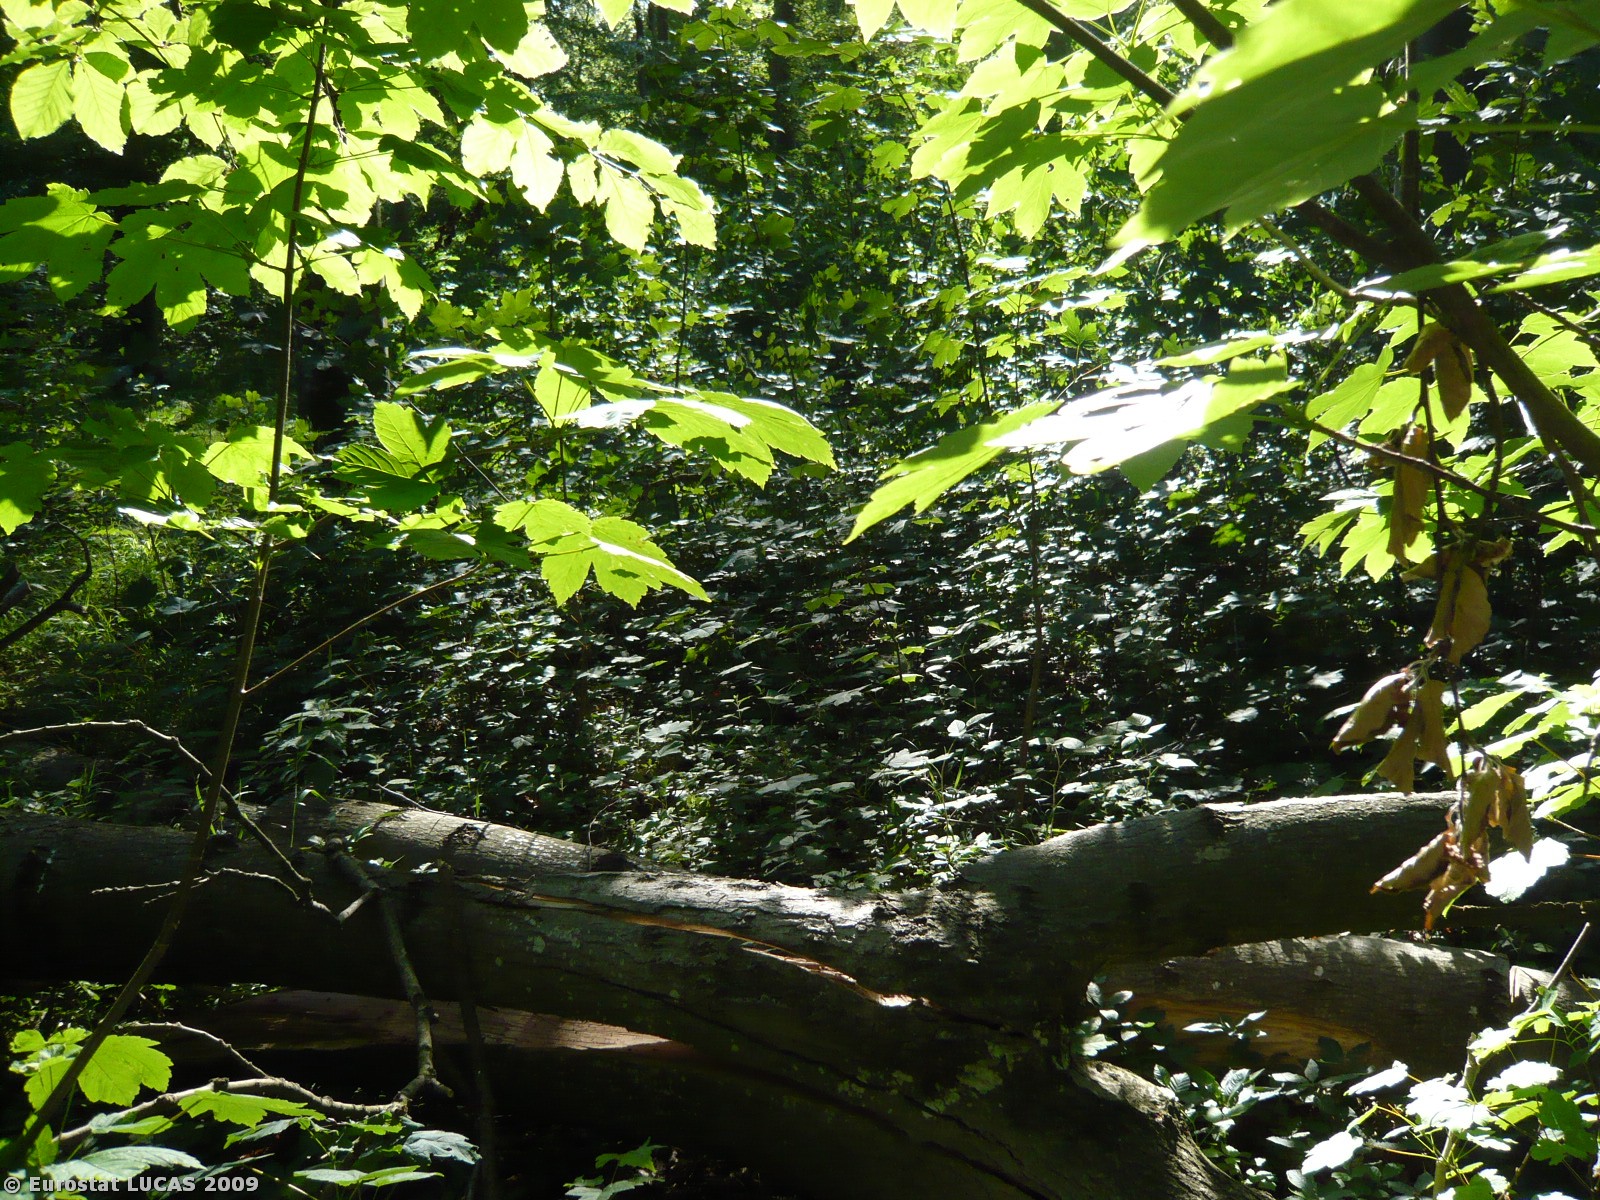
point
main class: Woodland
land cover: Broadleaved woodland
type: mesophytic deciduous forest
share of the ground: > 75 %
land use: Forestry
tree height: > 5 m
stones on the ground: < 10 %
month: June
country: DK
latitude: 54.8327
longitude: 11.3224
